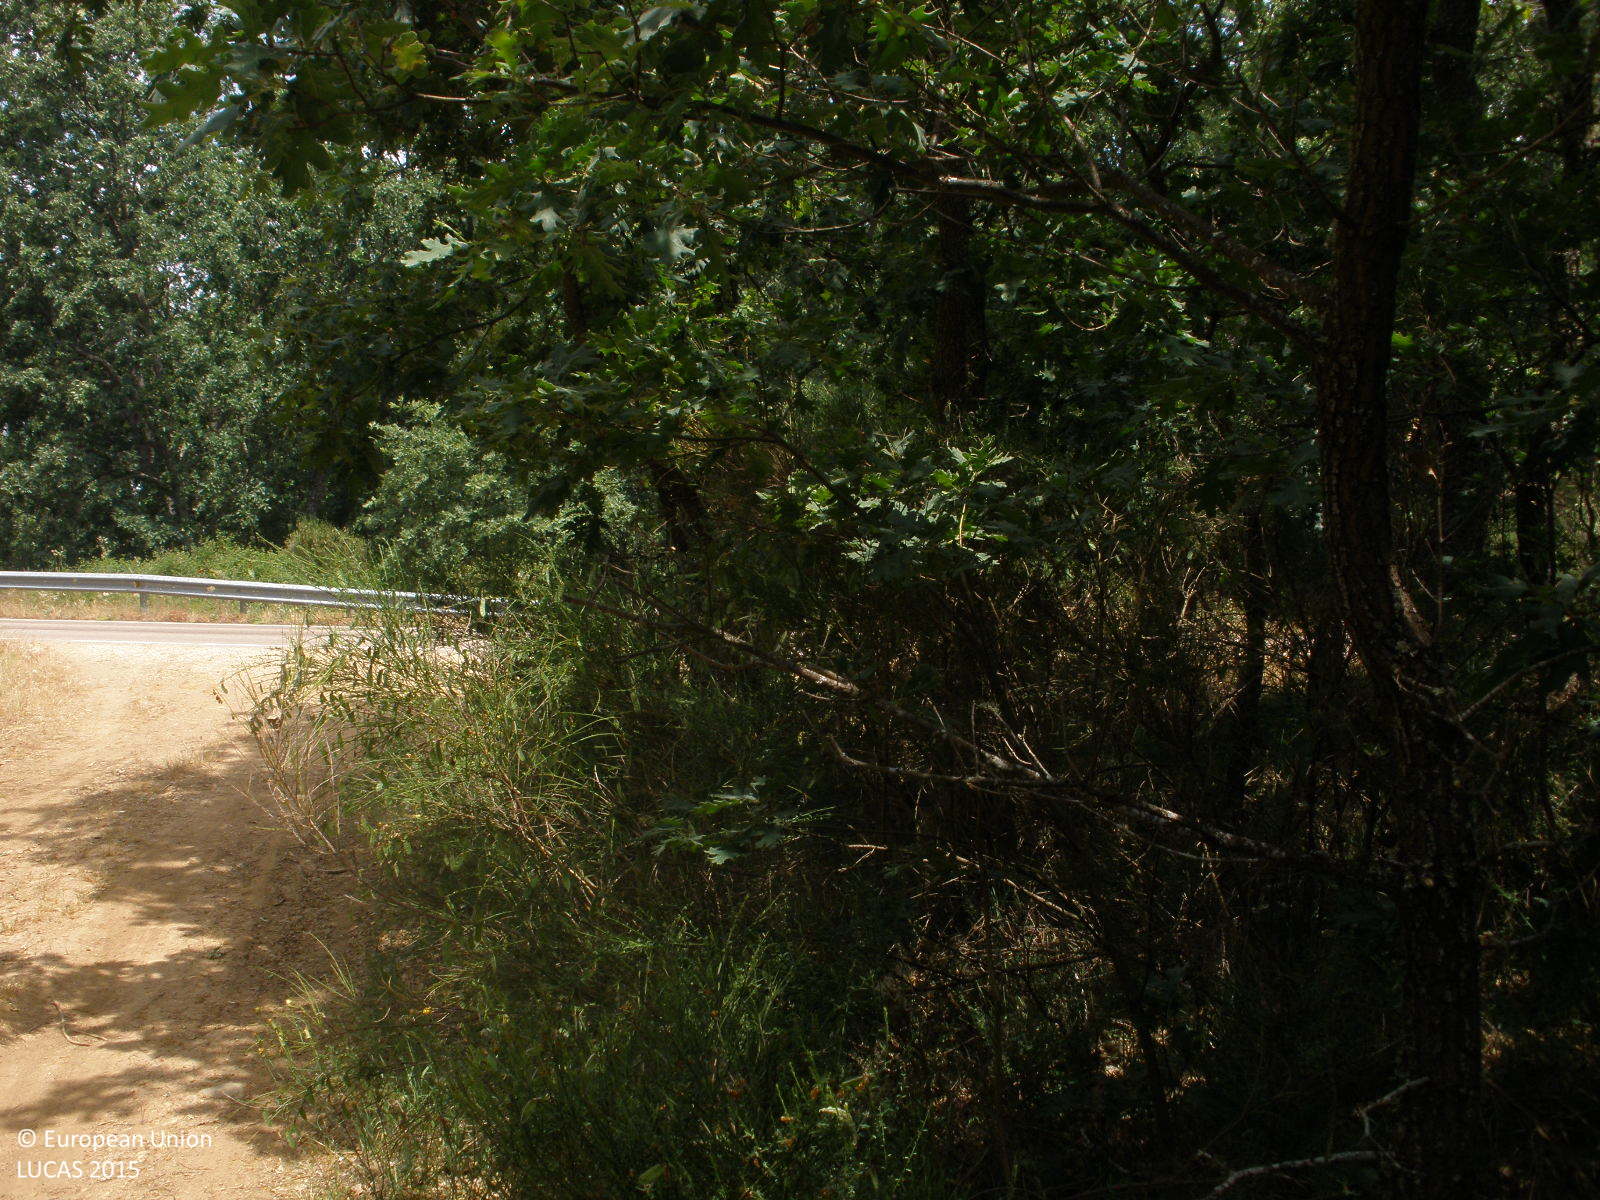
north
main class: Woodland
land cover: Broadleaved woodland
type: thermophilous deciduous forest
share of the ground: > 75 %
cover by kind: broadleaved forest trees 70 %, herbaceous plants 30 %
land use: Agriculture (excluding fallow land and kitchen gardens)
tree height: > 5 m
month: June
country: ES
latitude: 40.5566
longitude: -6.1540
